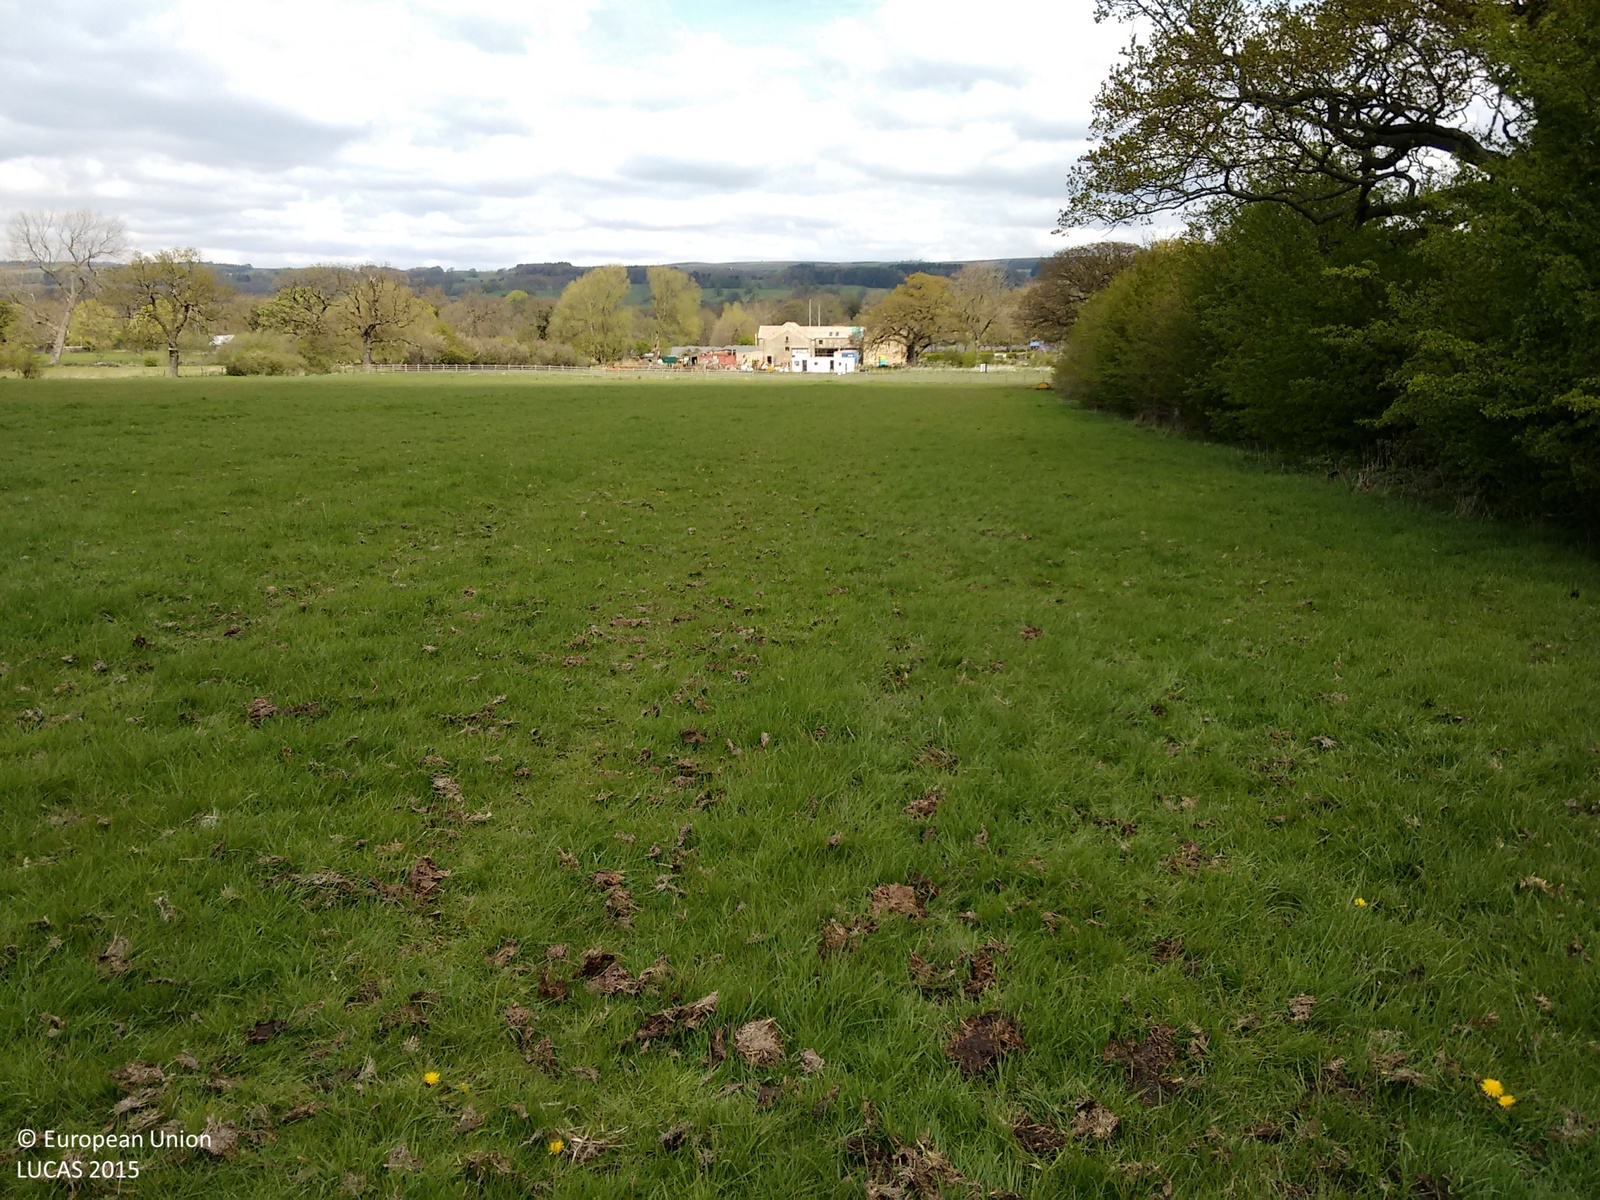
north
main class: Grassland
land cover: Grassland without tree/shrub cover
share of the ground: > 75 %
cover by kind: herbaceous plants 100 %
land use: Agriculture (excluding fallow land and kitchen gardens)
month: May
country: GB
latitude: 53.9171
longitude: -1.7616
